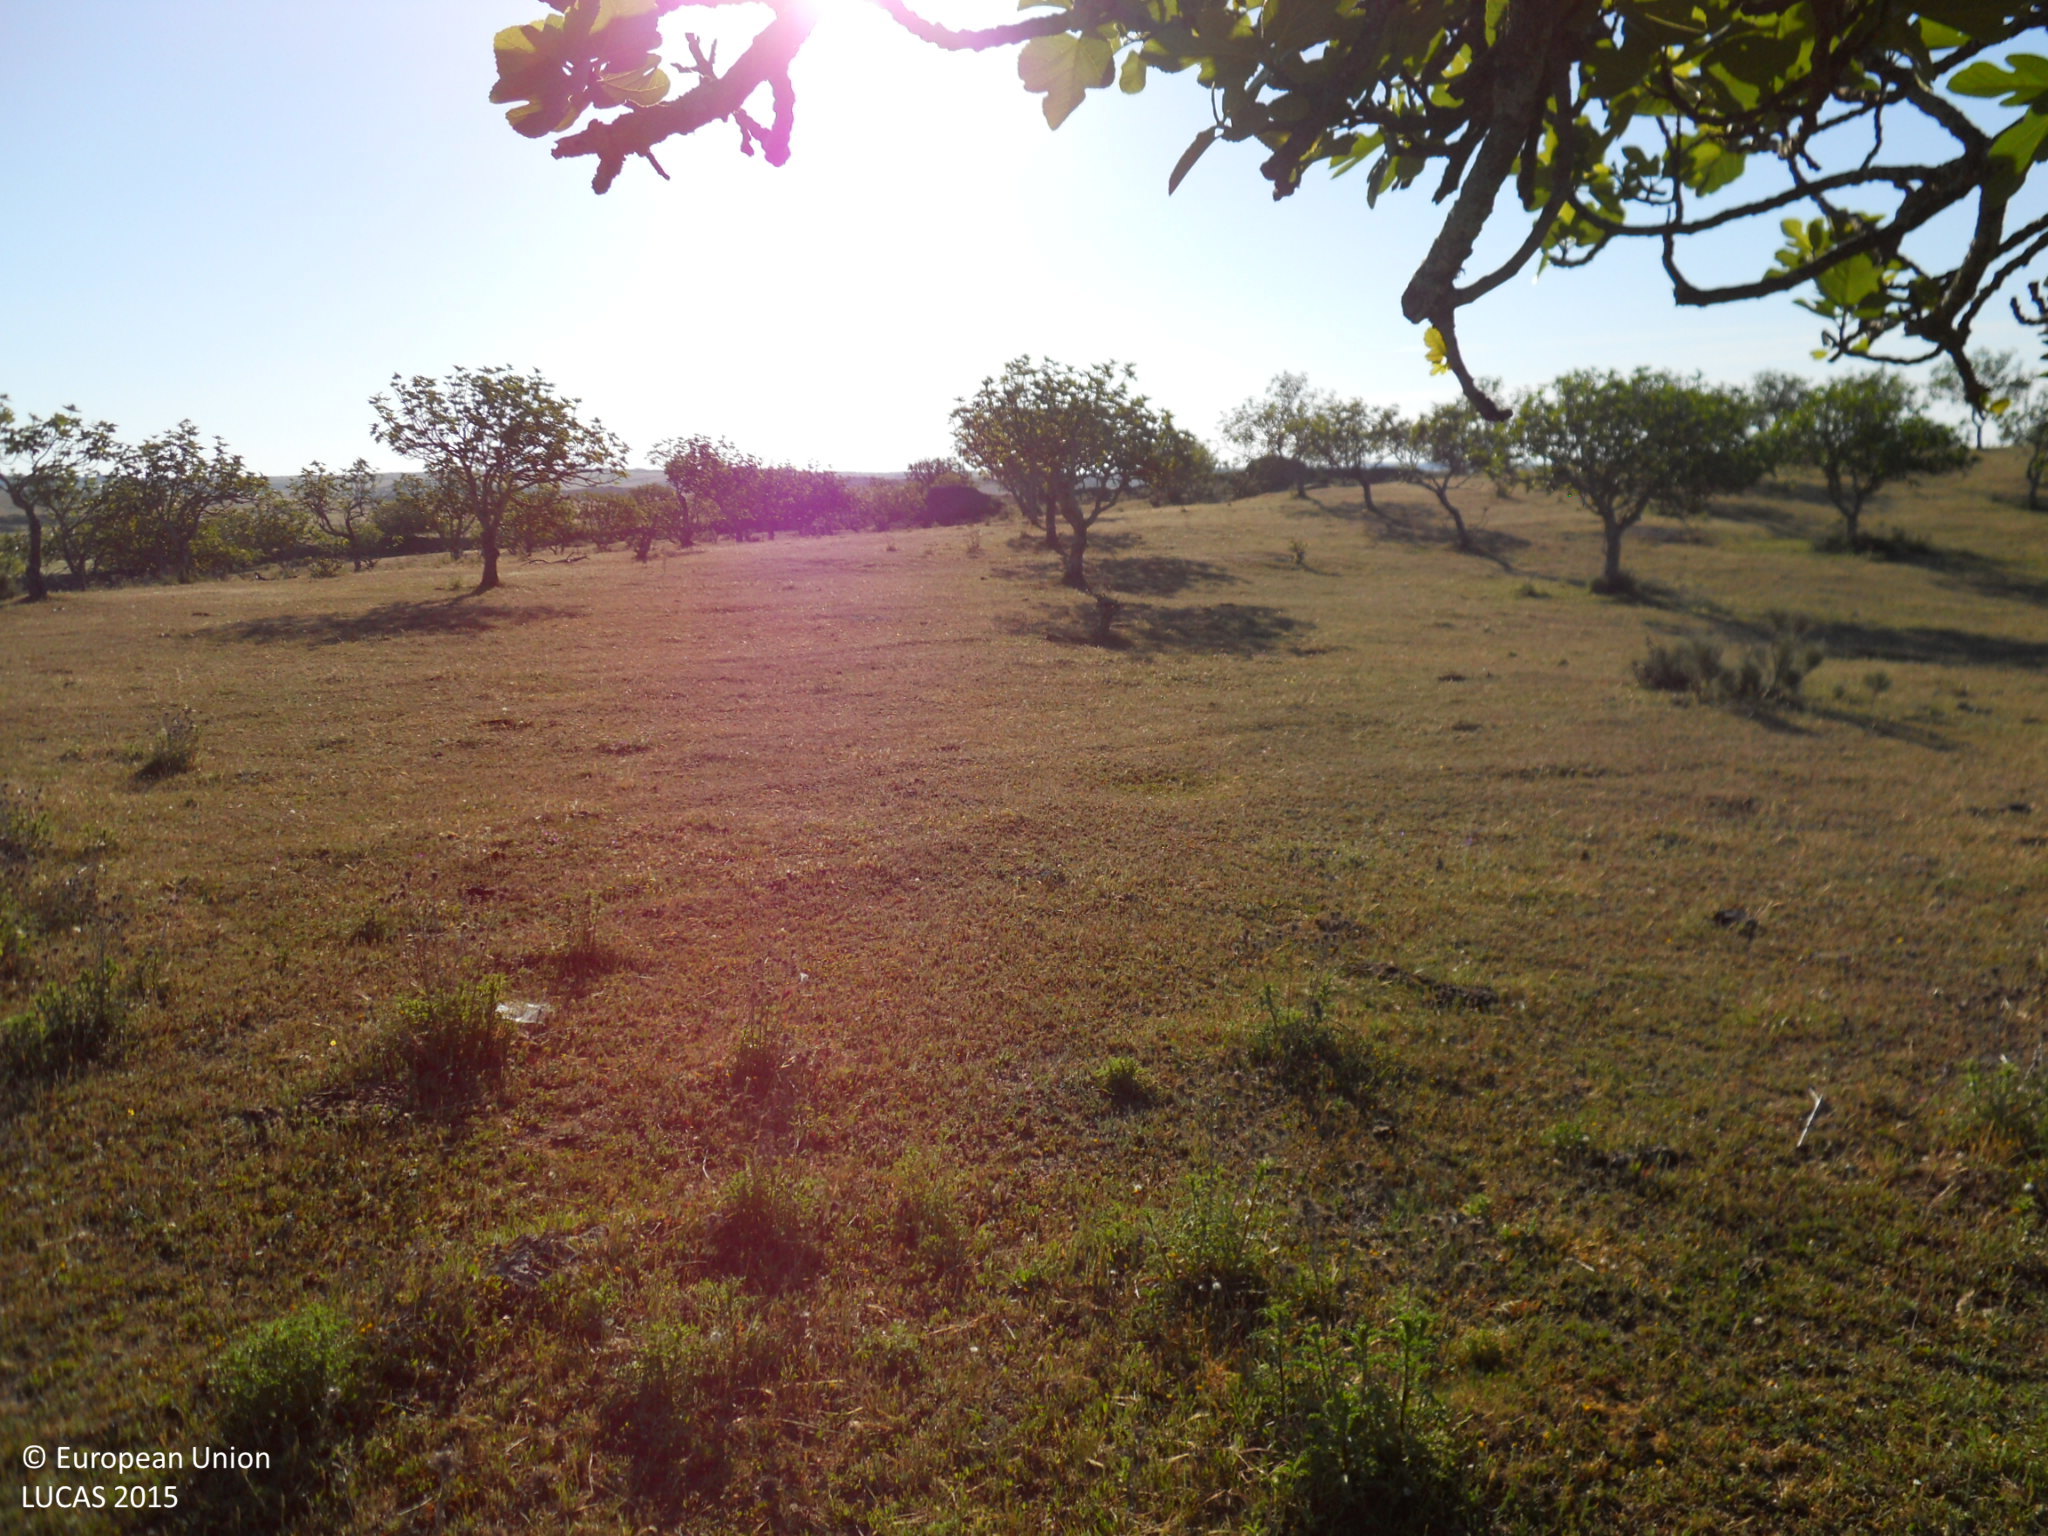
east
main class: Cropland
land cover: Other fruit trees and berries
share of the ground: 25 - 50 %
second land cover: Spontaneously vegetated surfaces
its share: > 75 %
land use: Agriculture (excluding fallow land and kitchen gardens)
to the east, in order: Other fruit trees and berries; Spontaneously vegetated surfaces; Grassland without tree/shrub cover; Rock outcrops; Dry stone walls; Spontaneously vegetated surfaces; Tracks; Spontaneously vegetated surfaces; Tracks; Spontaneously vegetated surfaces
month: April
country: ES
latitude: 39.2849
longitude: -7.0161
